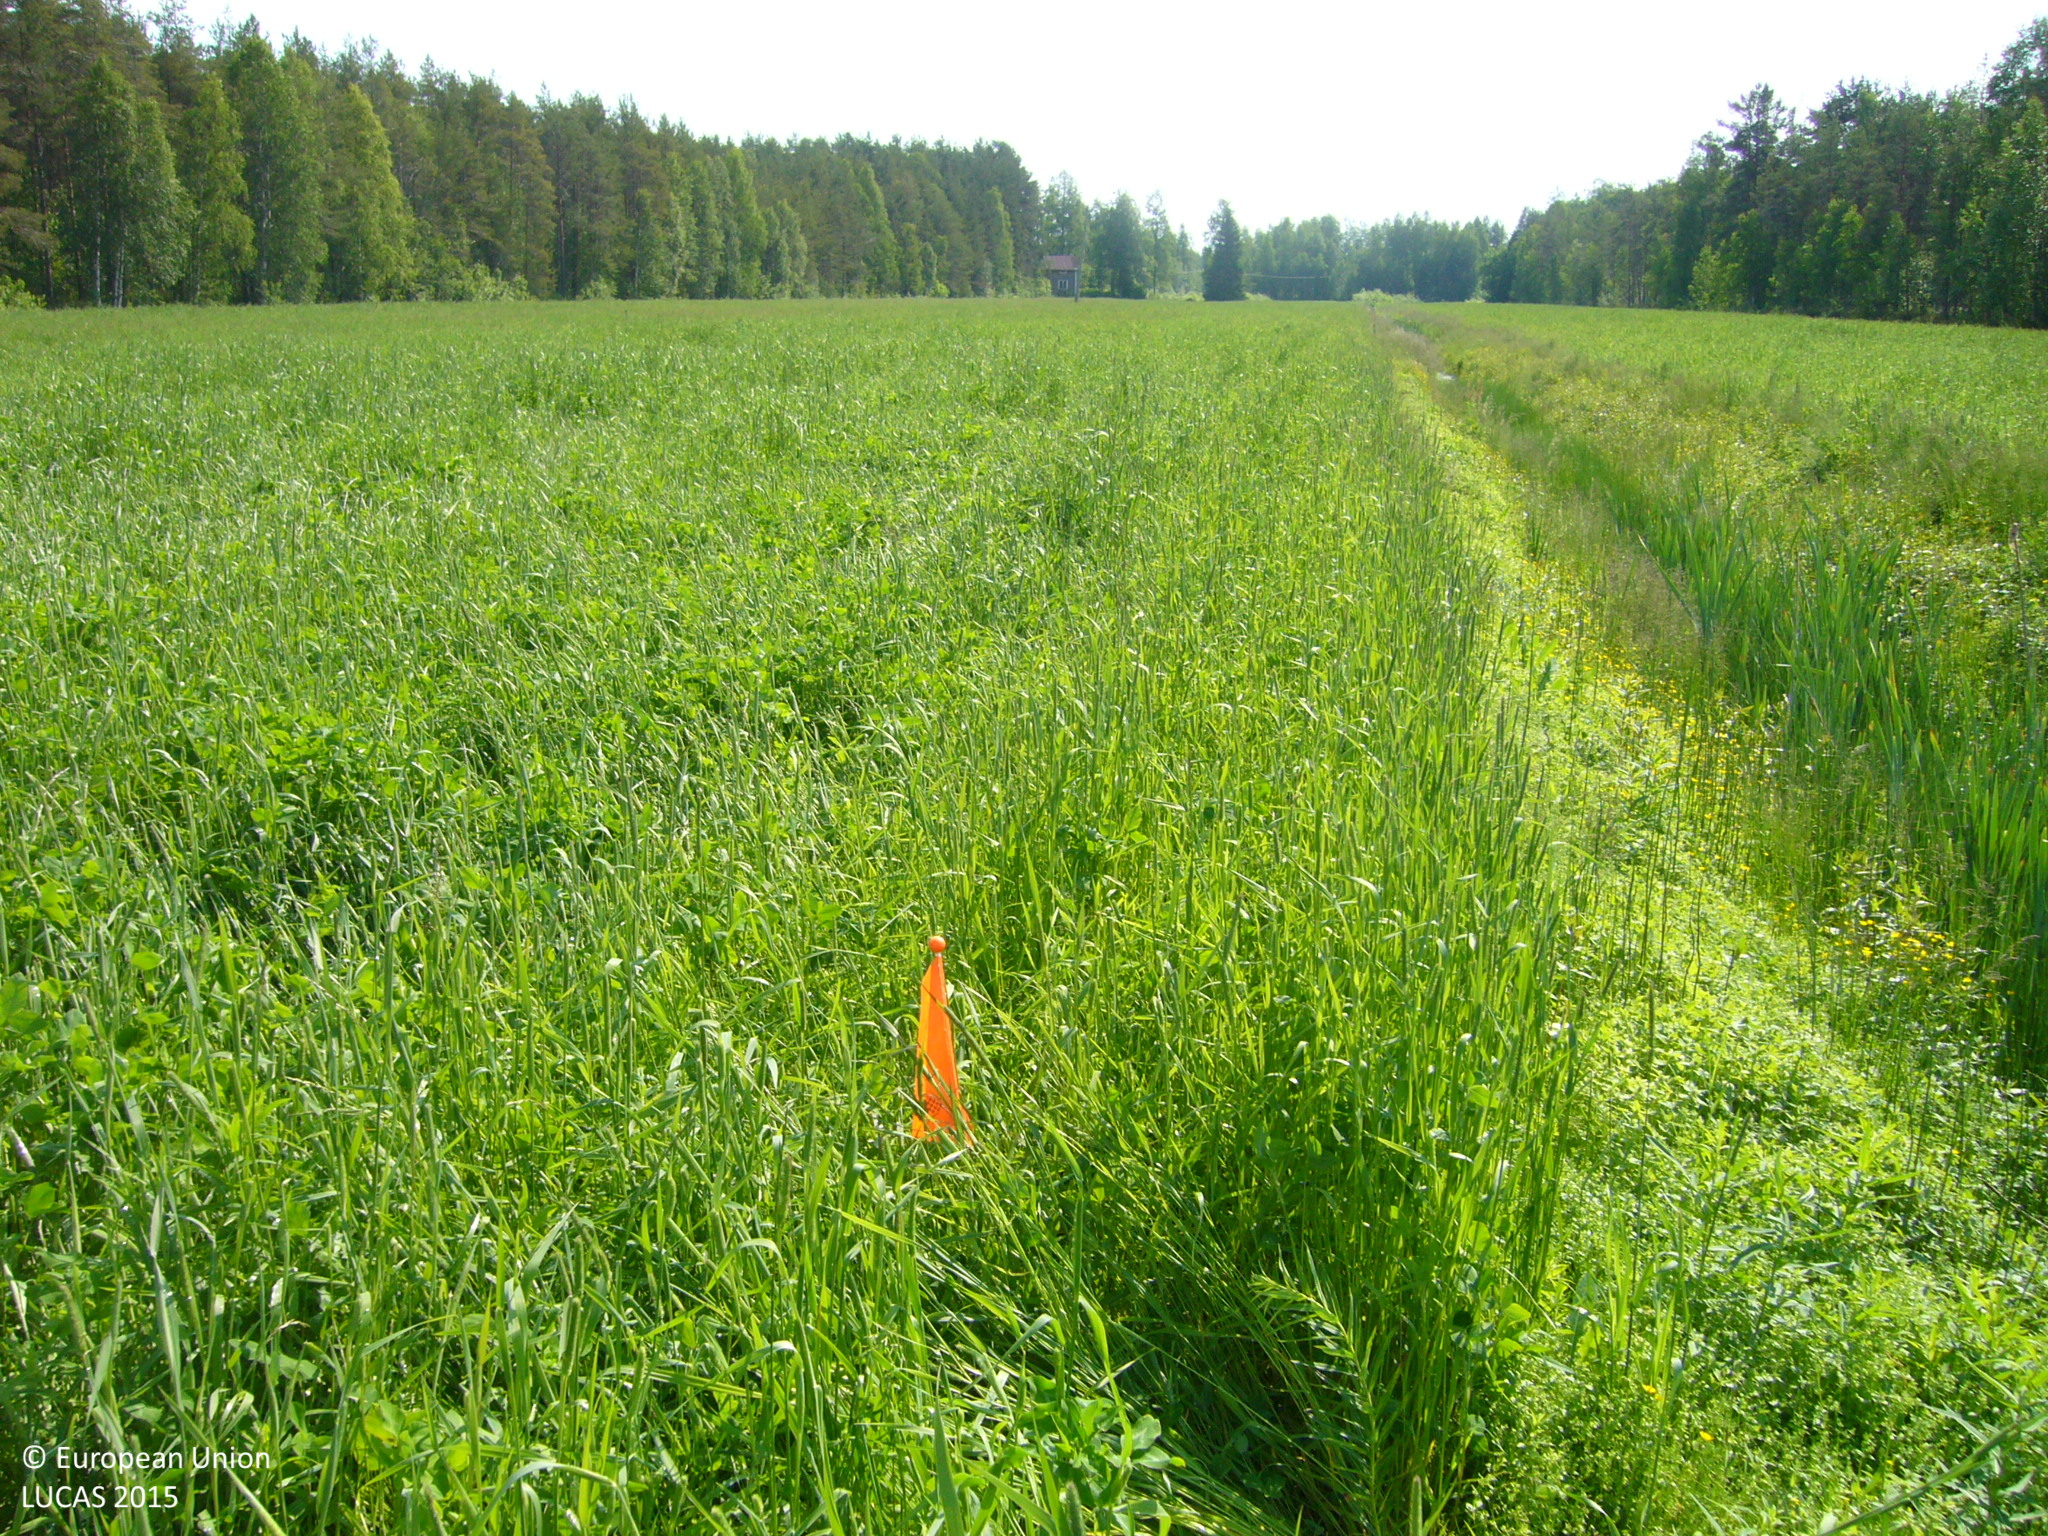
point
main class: Cropland
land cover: Temporary grasslands
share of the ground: > 75 %
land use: Agriculture (excluding fallow land and kitchen gardens)
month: July
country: FI
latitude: 63.6640
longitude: 25.8880
